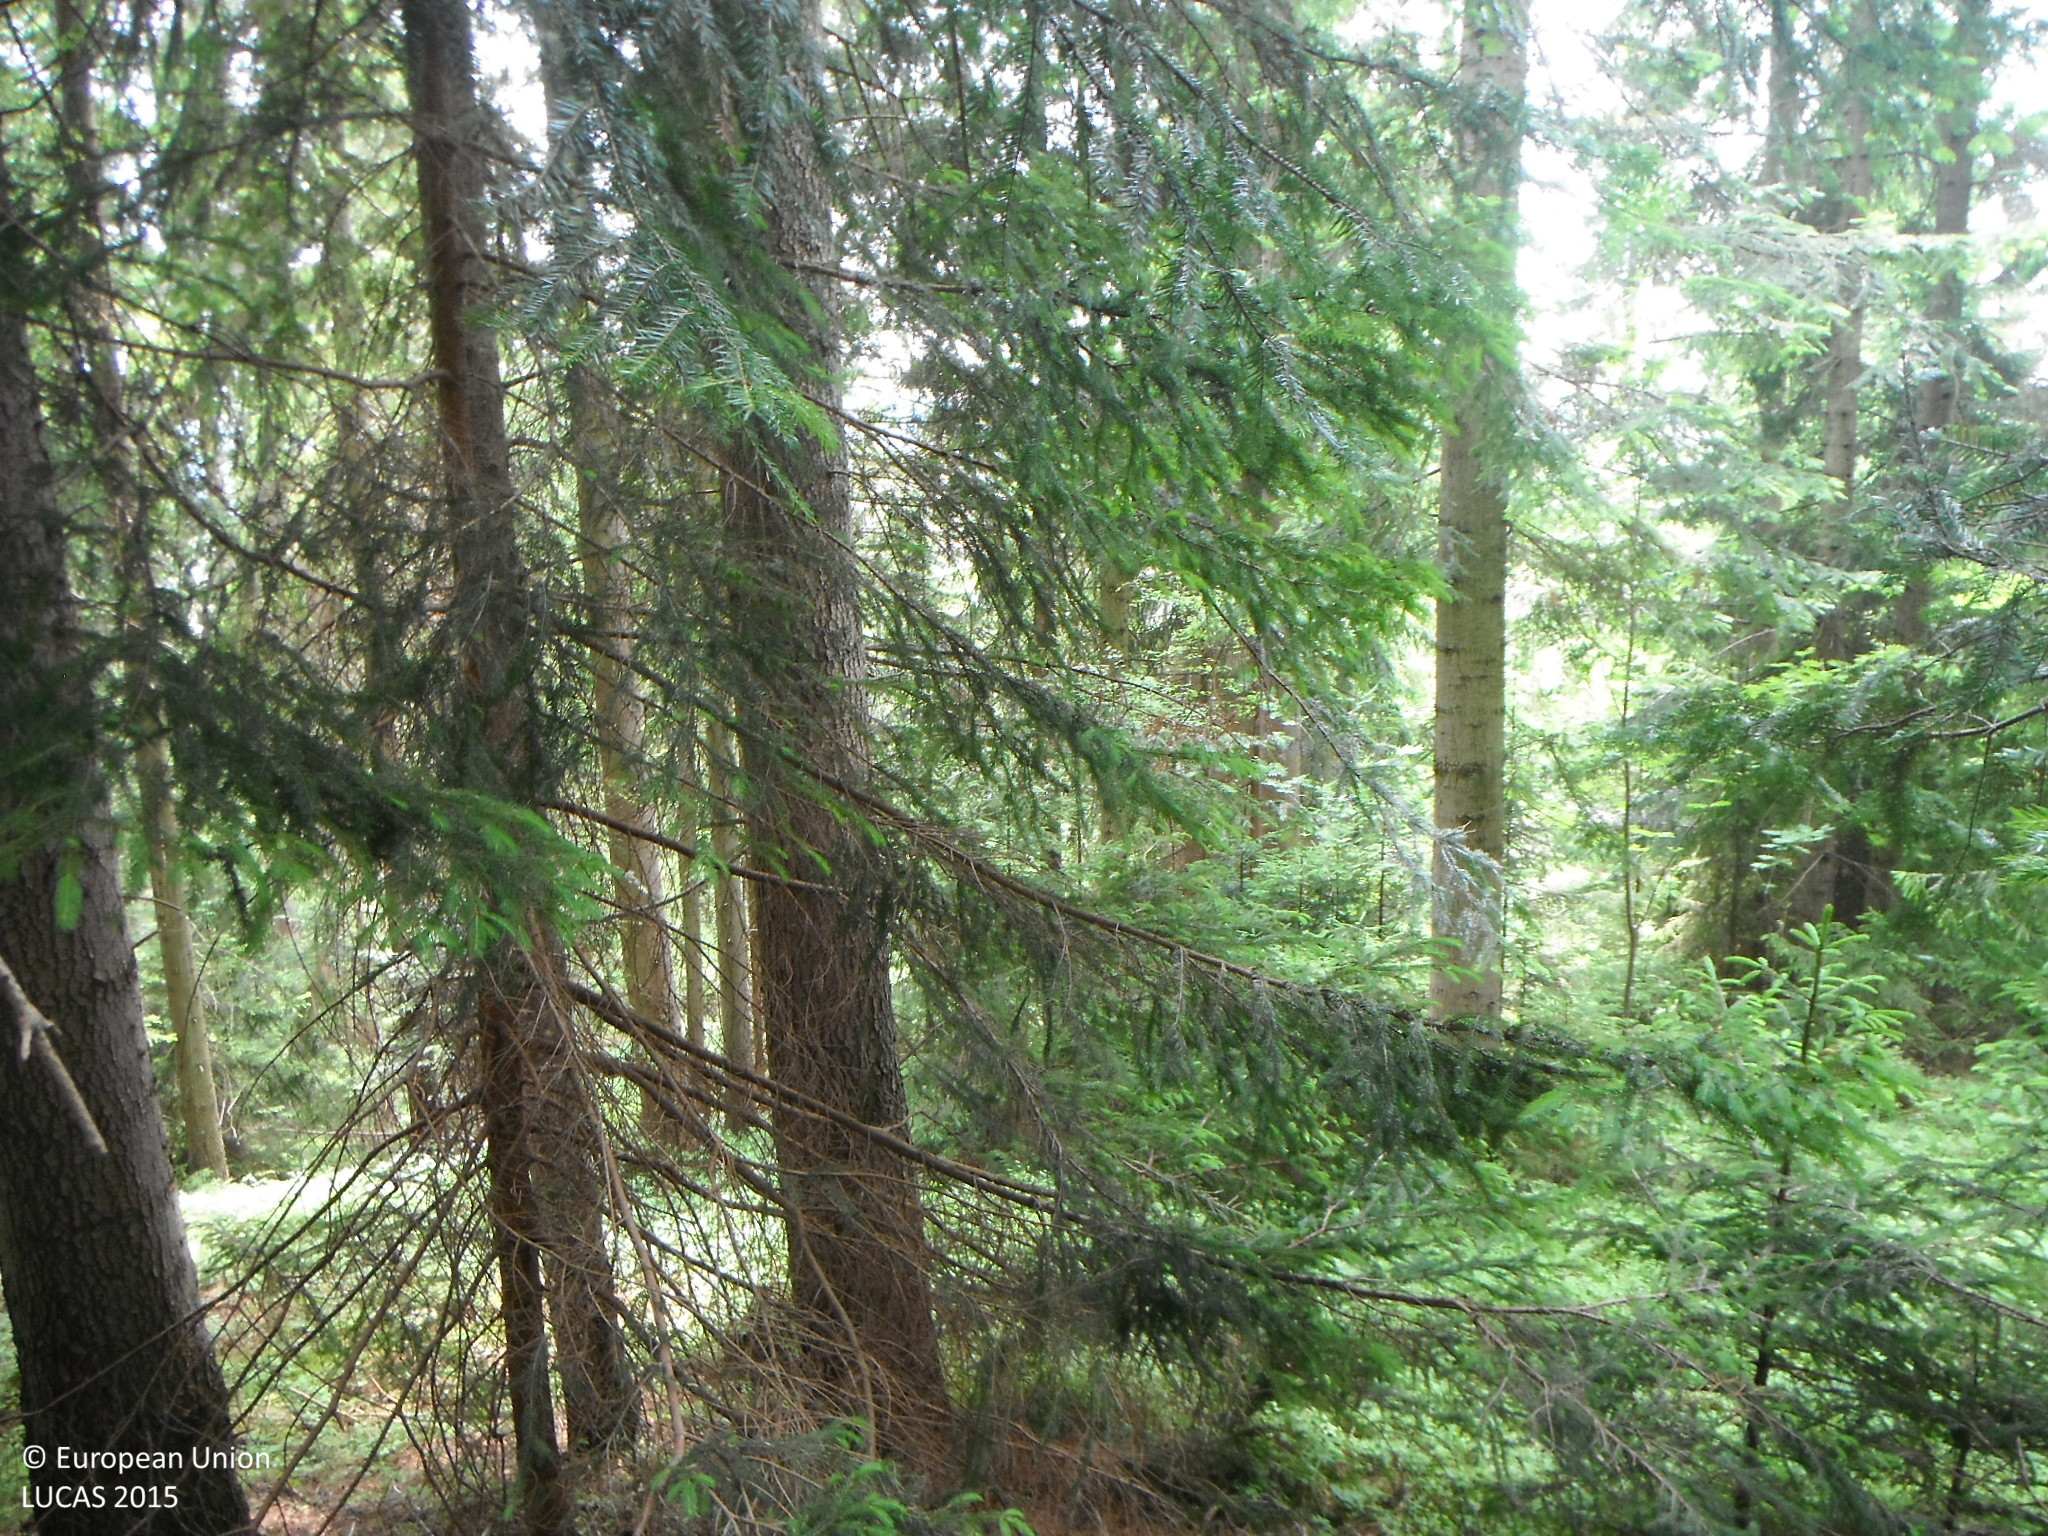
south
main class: Woodland
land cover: Spruce dominated coniferous woodland
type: alpine coniferous forest
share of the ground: > 75 %
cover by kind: coniferous forest trees 95 %, herbaceous plants 5 %
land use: Forestry
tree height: > 5 m
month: July
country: SK
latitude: 49.5115
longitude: 19.5430
